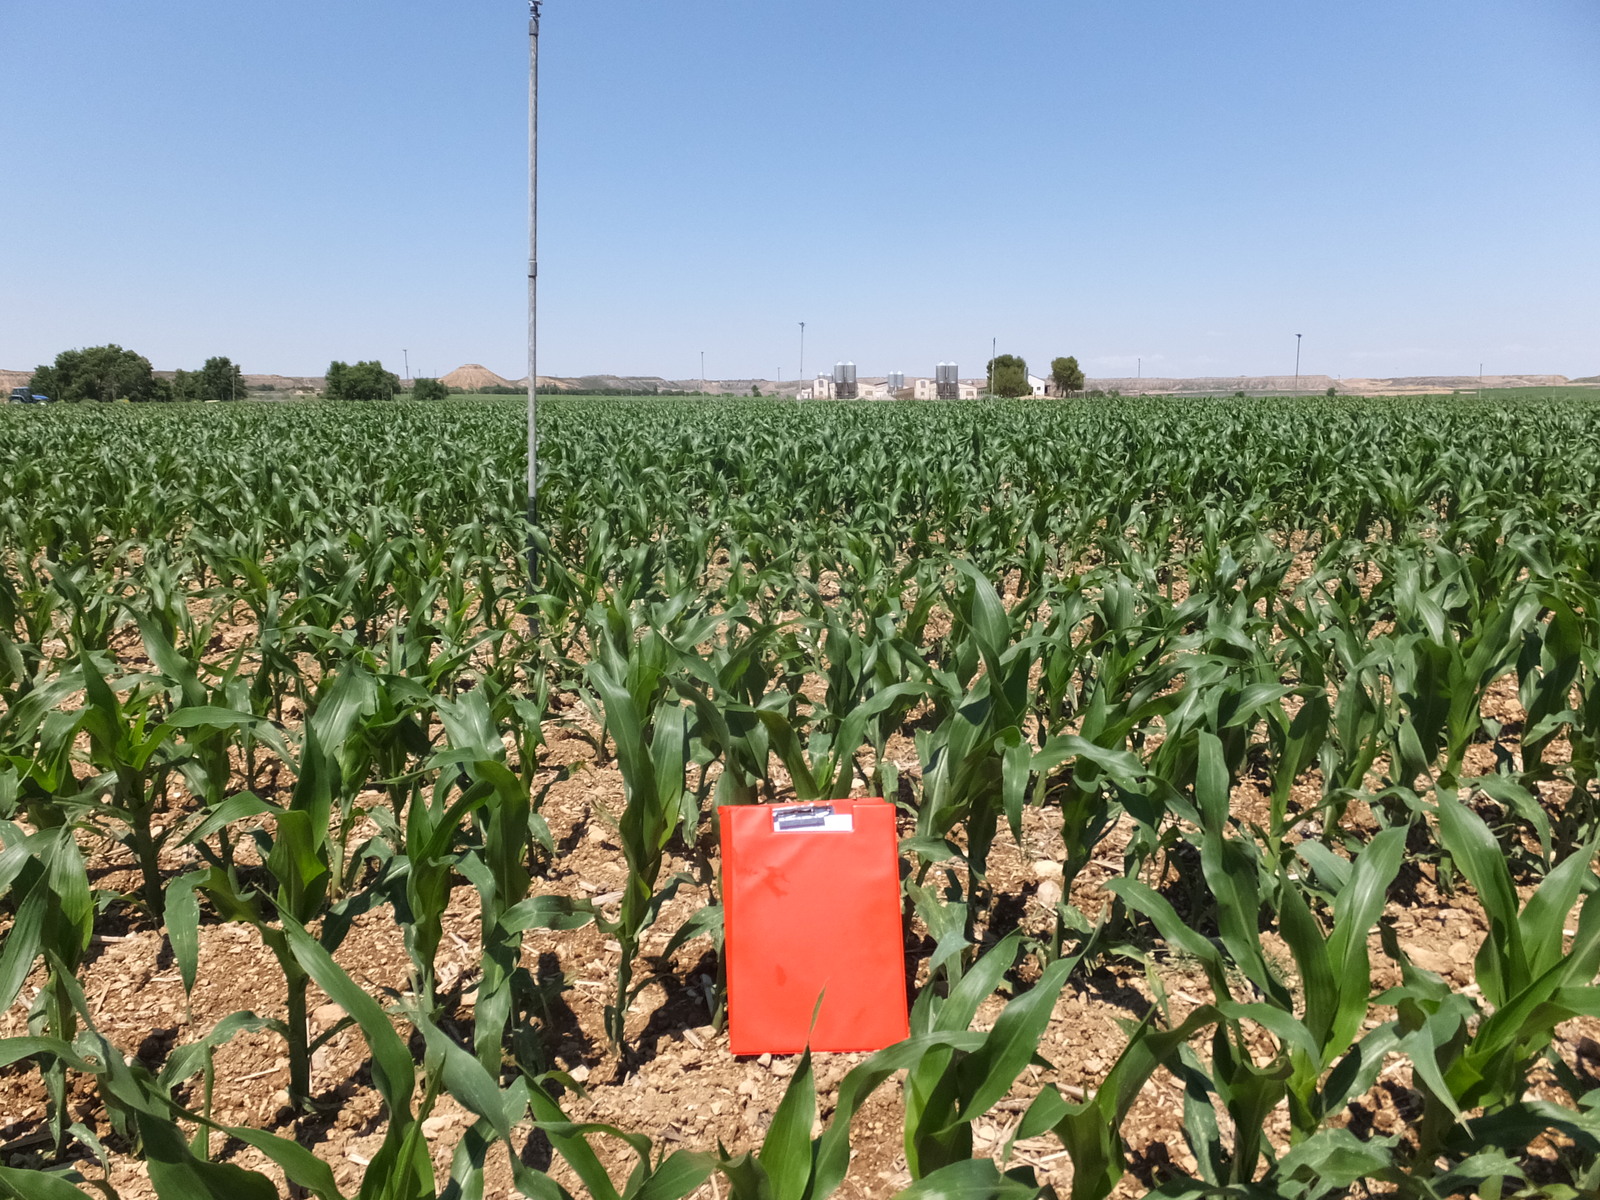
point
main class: Cropland
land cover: Maize
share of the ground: 10 - 25 %
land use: Agriculture (excluding fallow land and kitchen gardens)
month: June
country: ES
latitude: 41.5085
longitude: 0.0534
